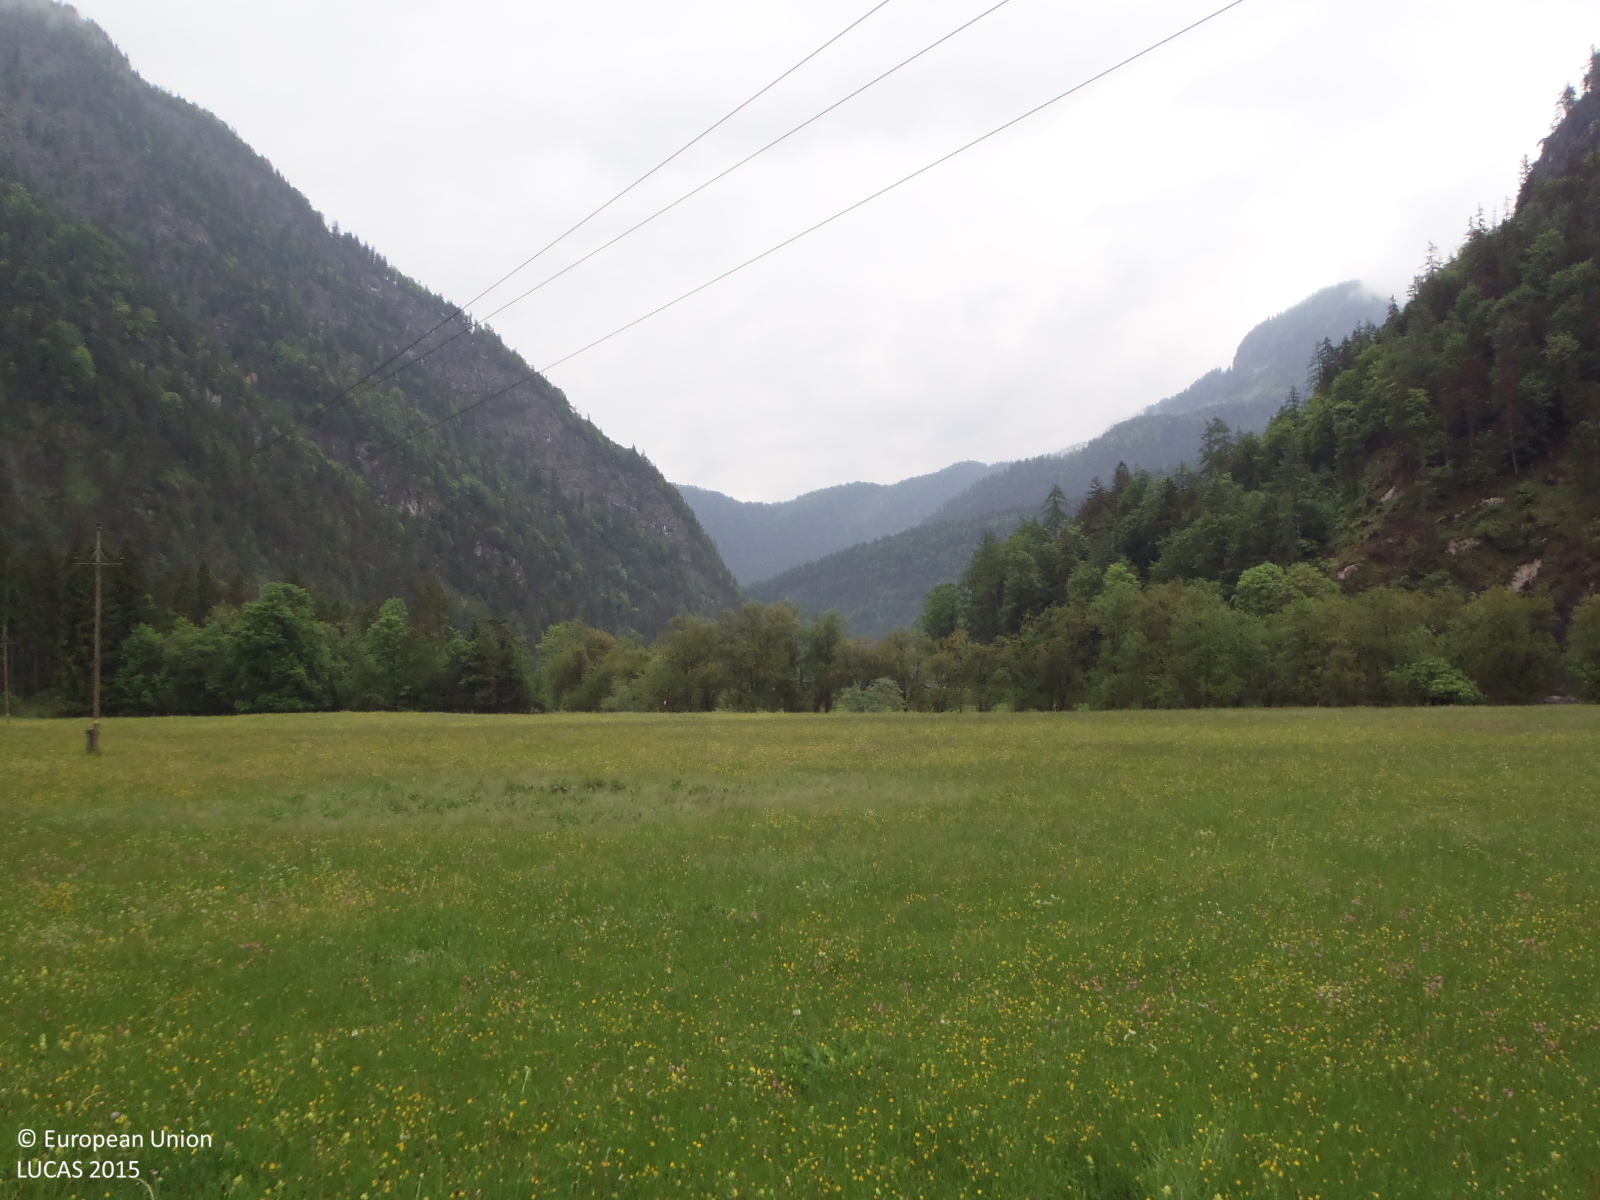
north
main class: Grassland
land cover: Grassland without tree/shrub cover
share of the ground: > 75 %
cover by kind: herbaceous plants 100 %
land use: Agriculture (excluding fallow land and kitchen gardens)
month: May
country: AT
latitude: 47.5417
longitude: 12.7219
